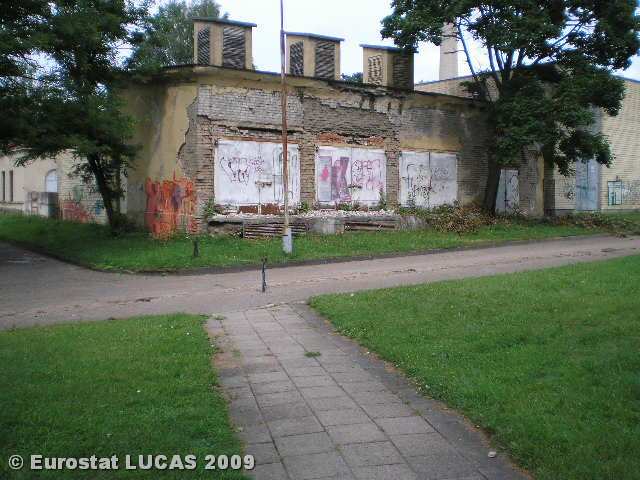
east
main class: Grassland
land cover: Grassland without tree/shrub cover
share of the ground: > 75 %
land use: Residential
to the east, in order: Grassland without tree/shrub cover; Paved roads, cycling and walking lanes; Grassland without tree/shrub cover; Artificial constructions in urban areas
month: July
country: LT
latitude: 54.7099
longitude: 25.3173
